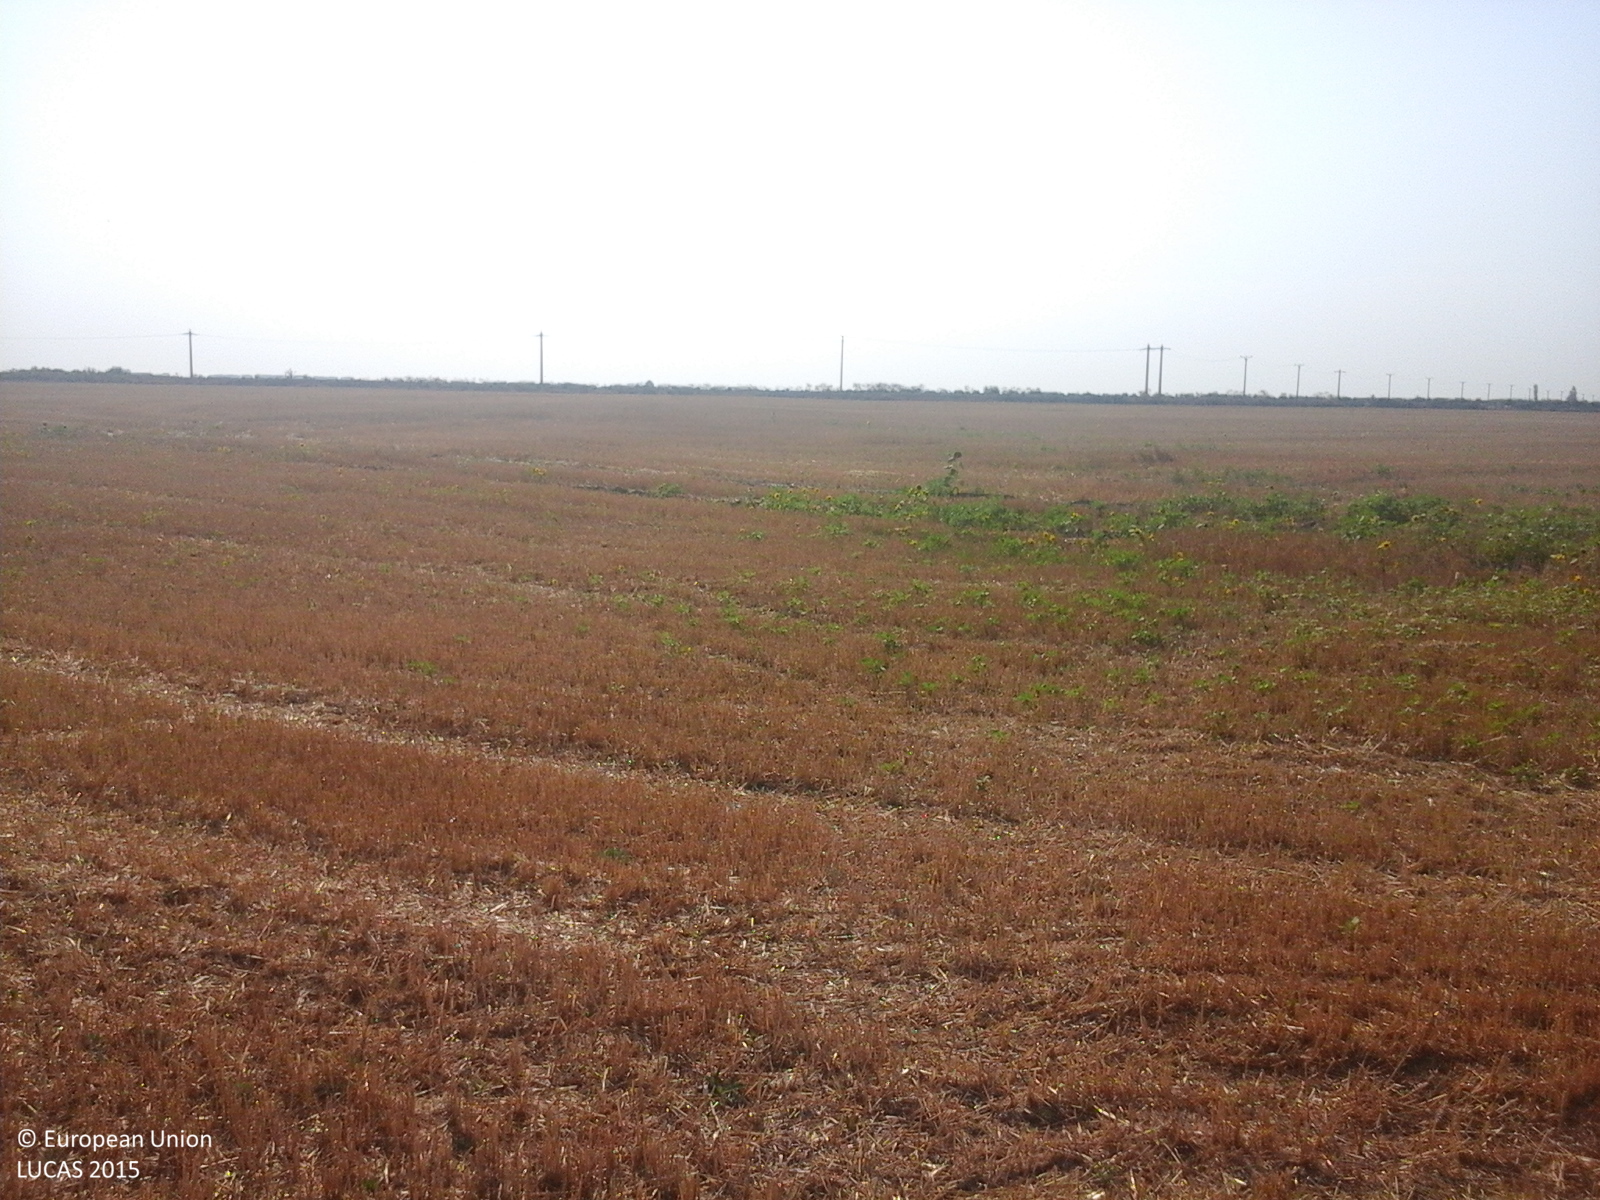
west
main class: Artificial land
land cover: Other artificial areas
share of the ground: > 75 %
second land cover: Durum wheat
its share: 10 - 25 %
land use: Electricity, gas and thermal power distribution
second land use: Agriculture (excluding fallow land and kitchen gardens)
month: August
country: RO
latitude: 44.8860
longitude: 28.0798
